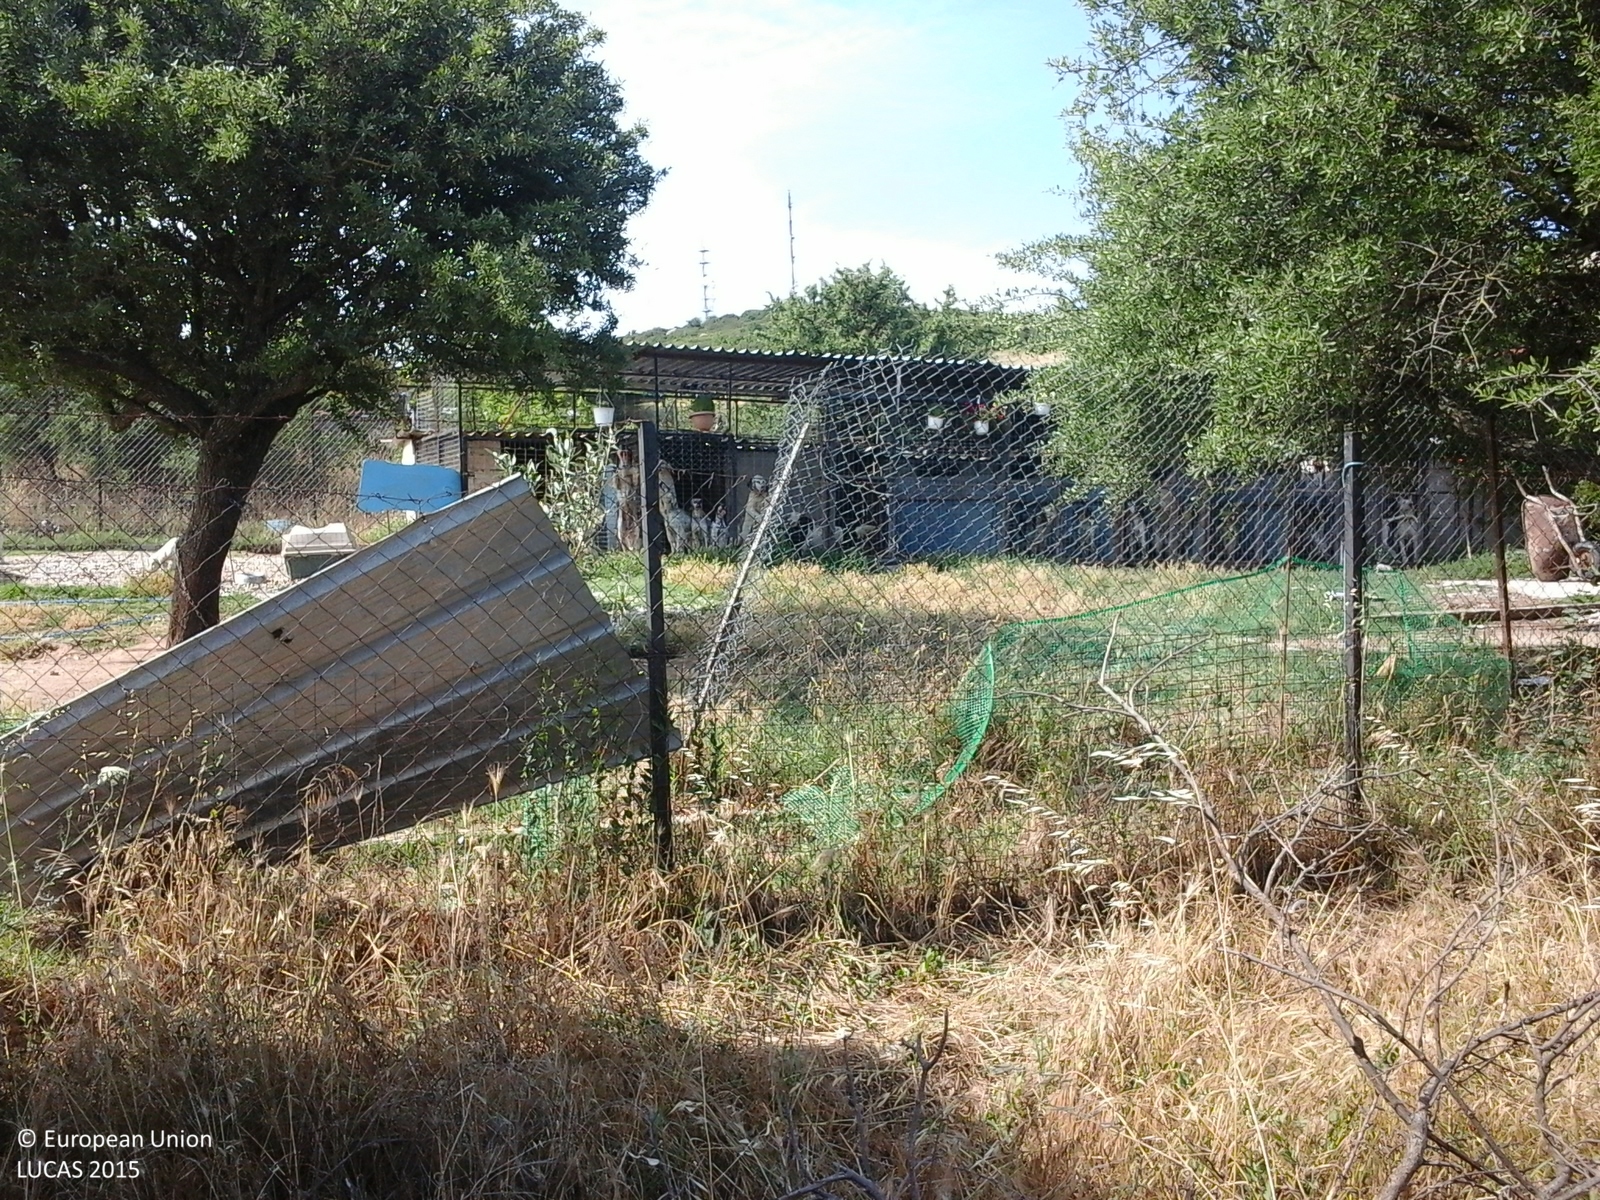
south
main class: Grassland
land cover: Spontaneously vegetated surfaces
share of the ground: > 75 %
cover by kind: herbaceous plants 100 %
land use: Semi-natural and natural areas not in use
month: June
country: GR
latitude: 40.6807
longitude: 22.9874
